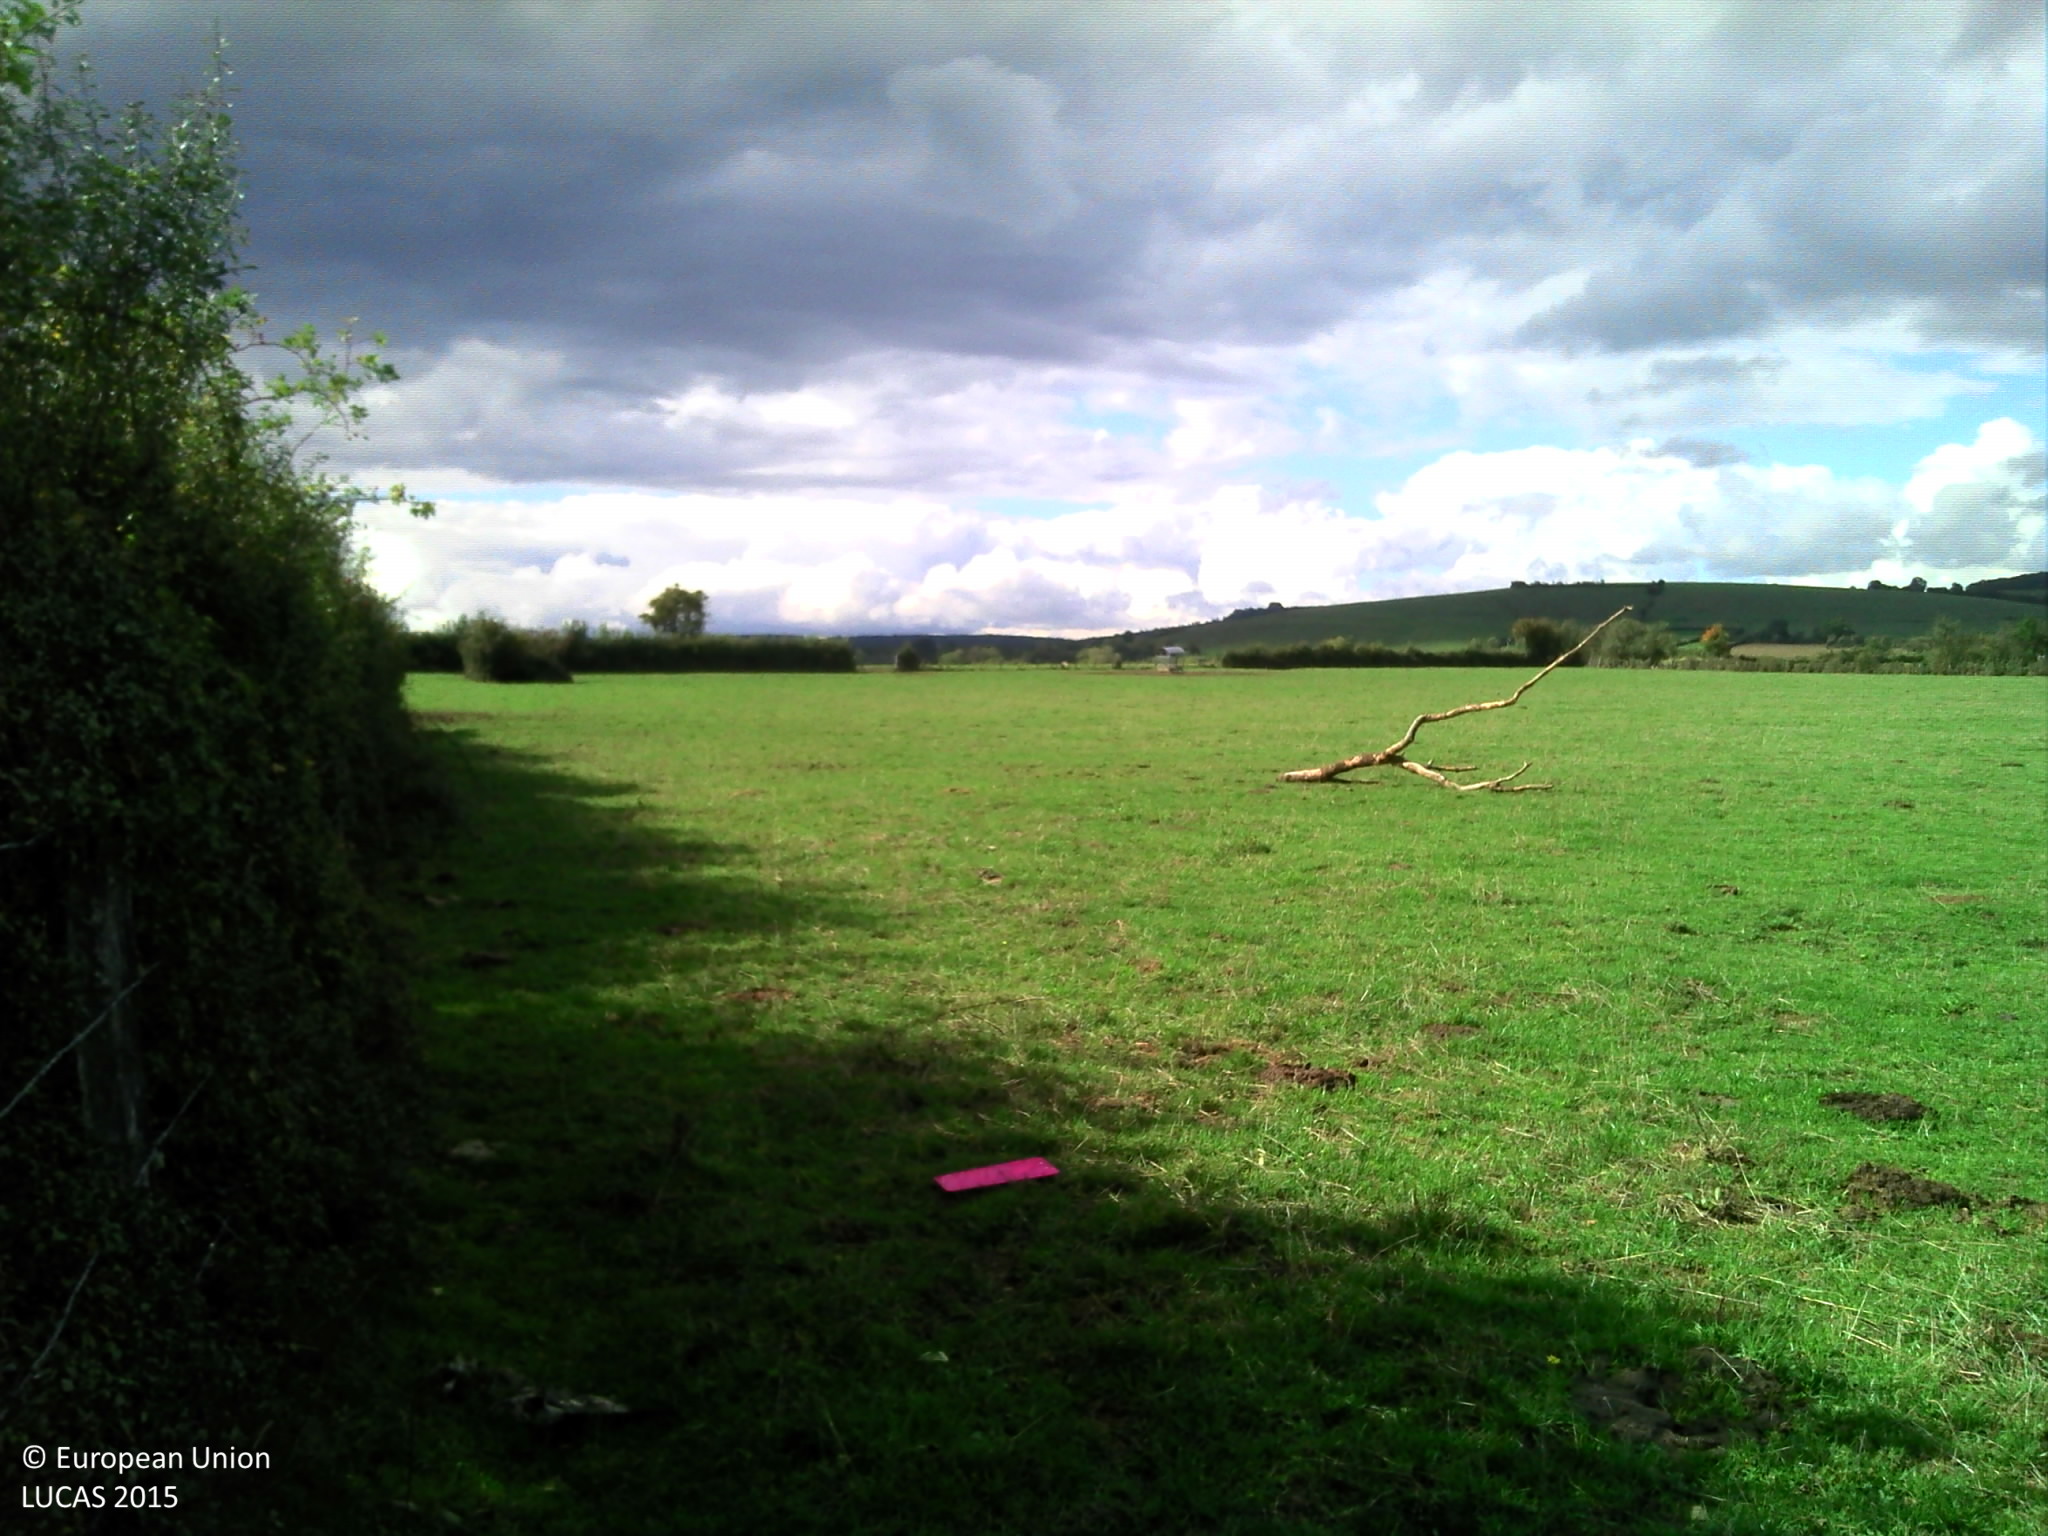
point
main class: Grassland
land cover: Grassland without tree/shrub cover
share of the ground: > 75 %
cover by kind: herbaceous plants 100 %
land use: Agriculture (excluding fallow land and kitchen gardens)
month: September
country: FR
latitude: 47.1967
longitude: 4.3897
